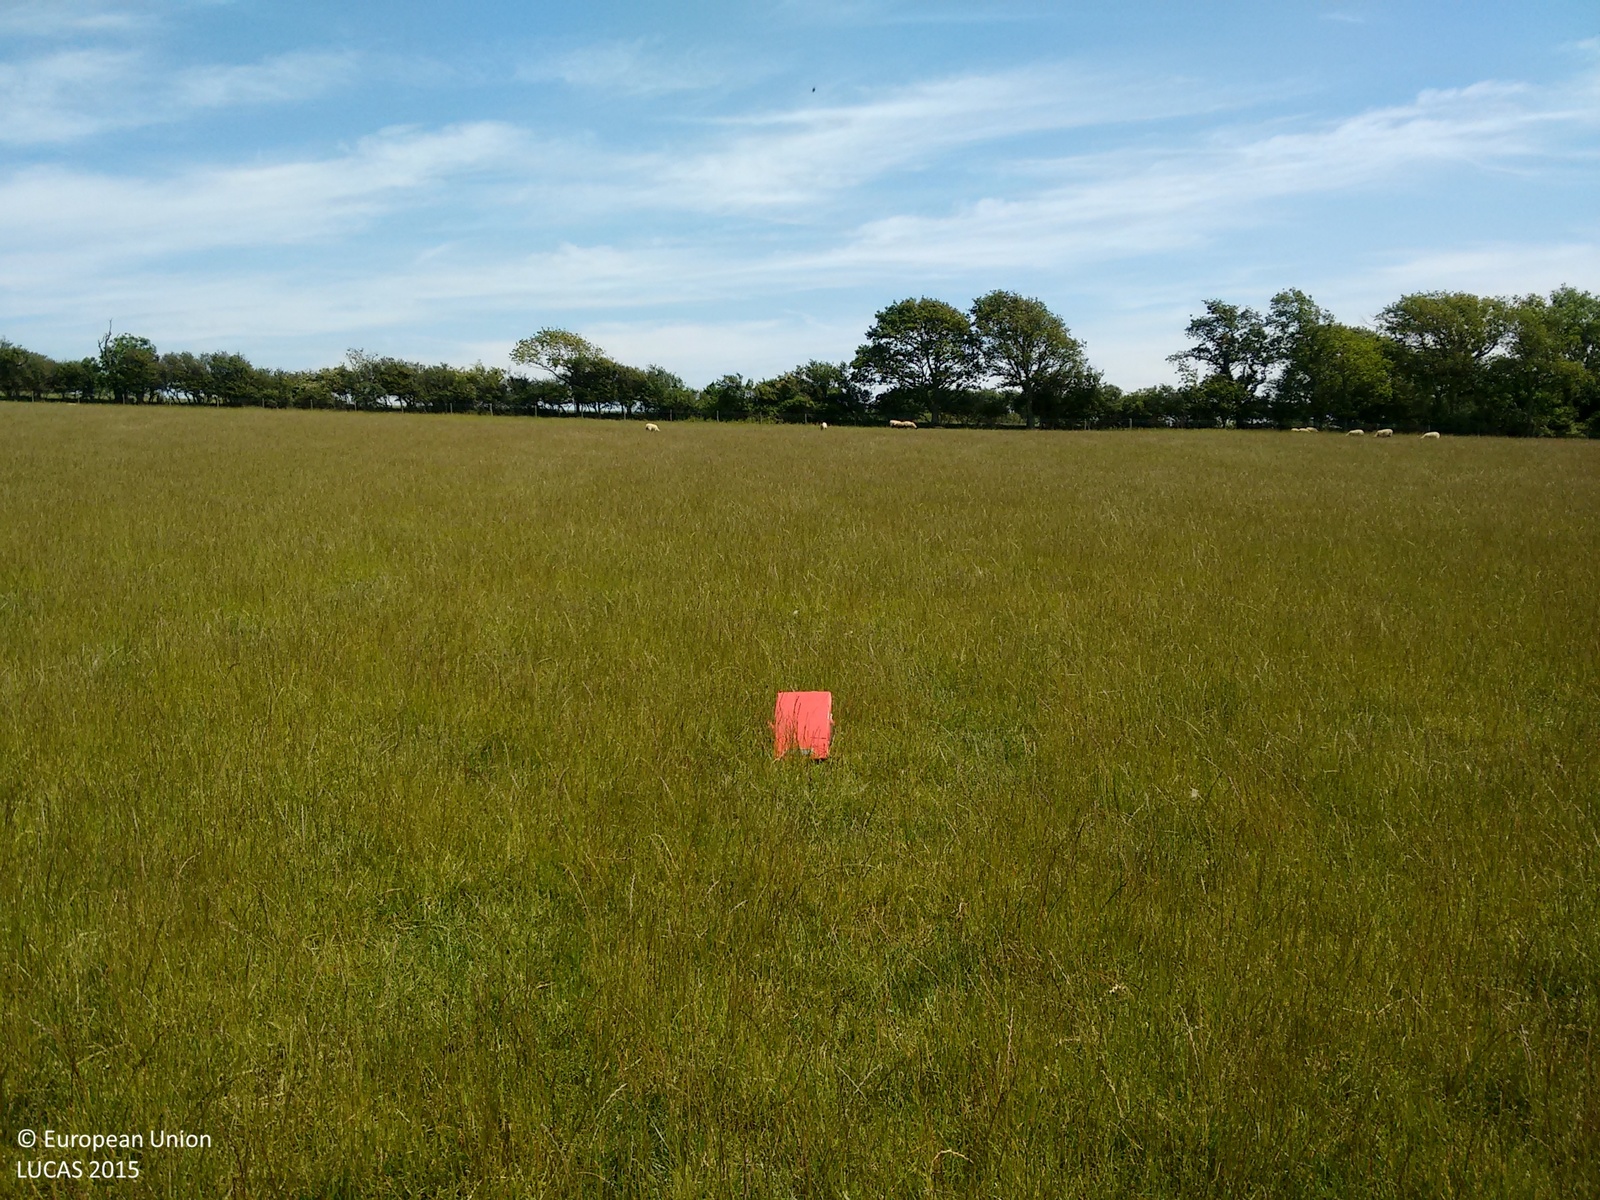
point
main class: Grassland
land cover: Grassland without tree/shrub cover
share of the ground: > 75 %
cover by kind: herbaceous plants 100 %
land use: Agriculture (excluding fallow land and kitchen gardens)
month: June
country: GB
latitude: 50.8312
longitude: 0.2154
